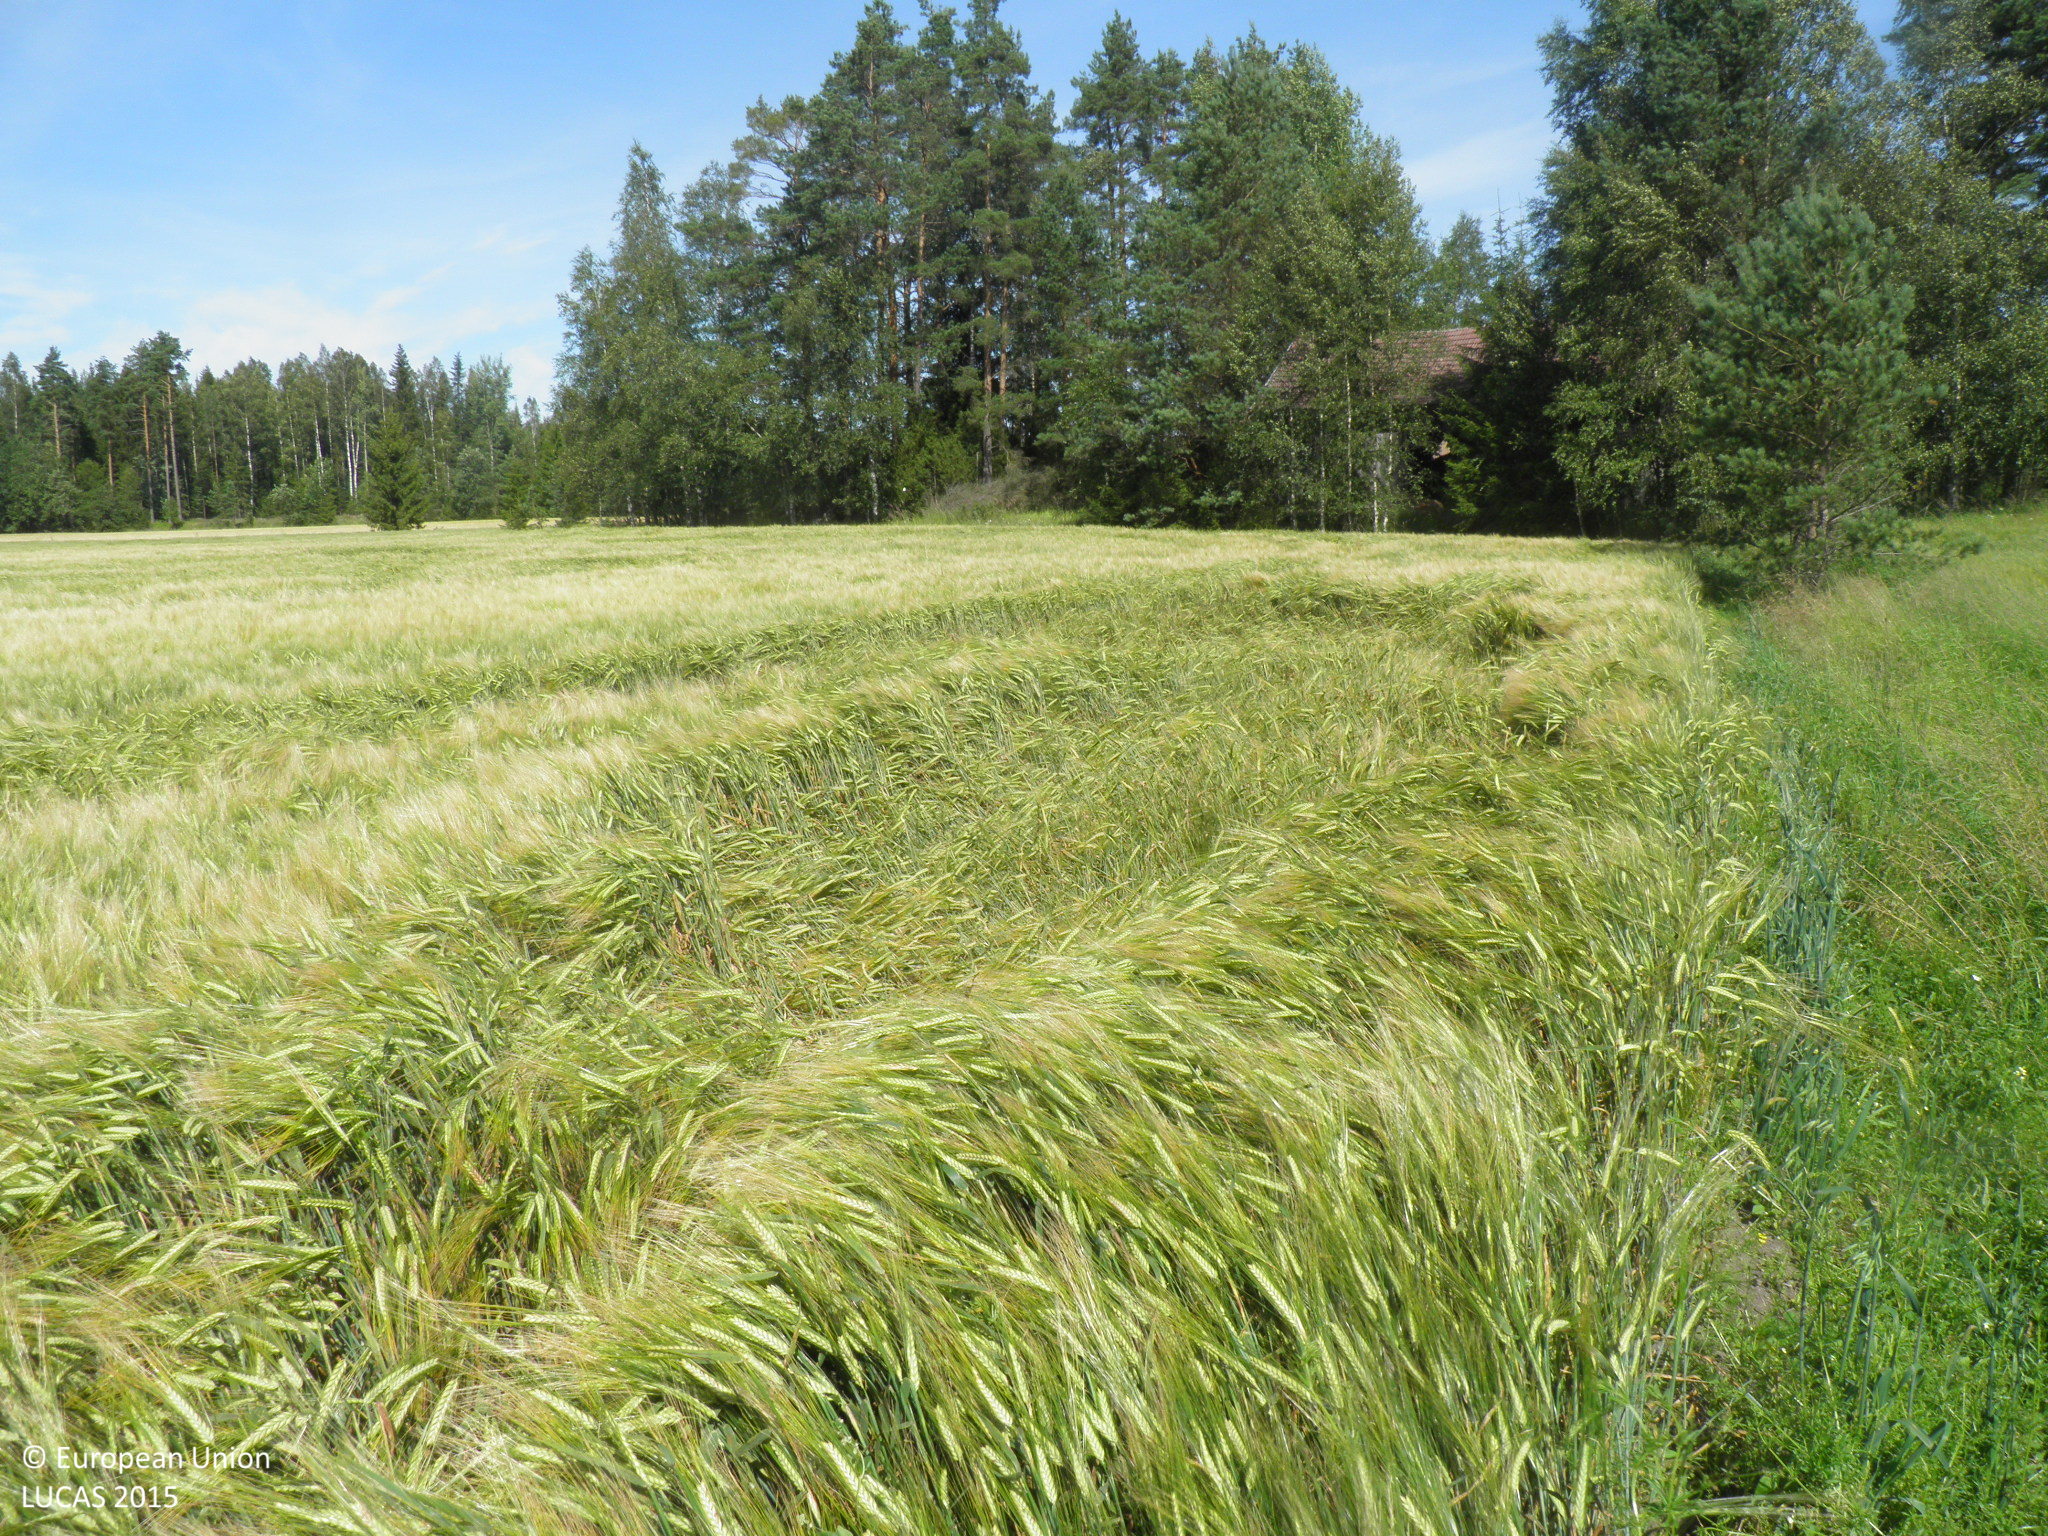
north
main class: Cropland
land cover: Barley
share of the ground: > 75 %
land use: Agriculture (excluding fallow land and kitchen gardens)
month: August
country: FI
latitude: 61.0185
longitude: 22.8193
